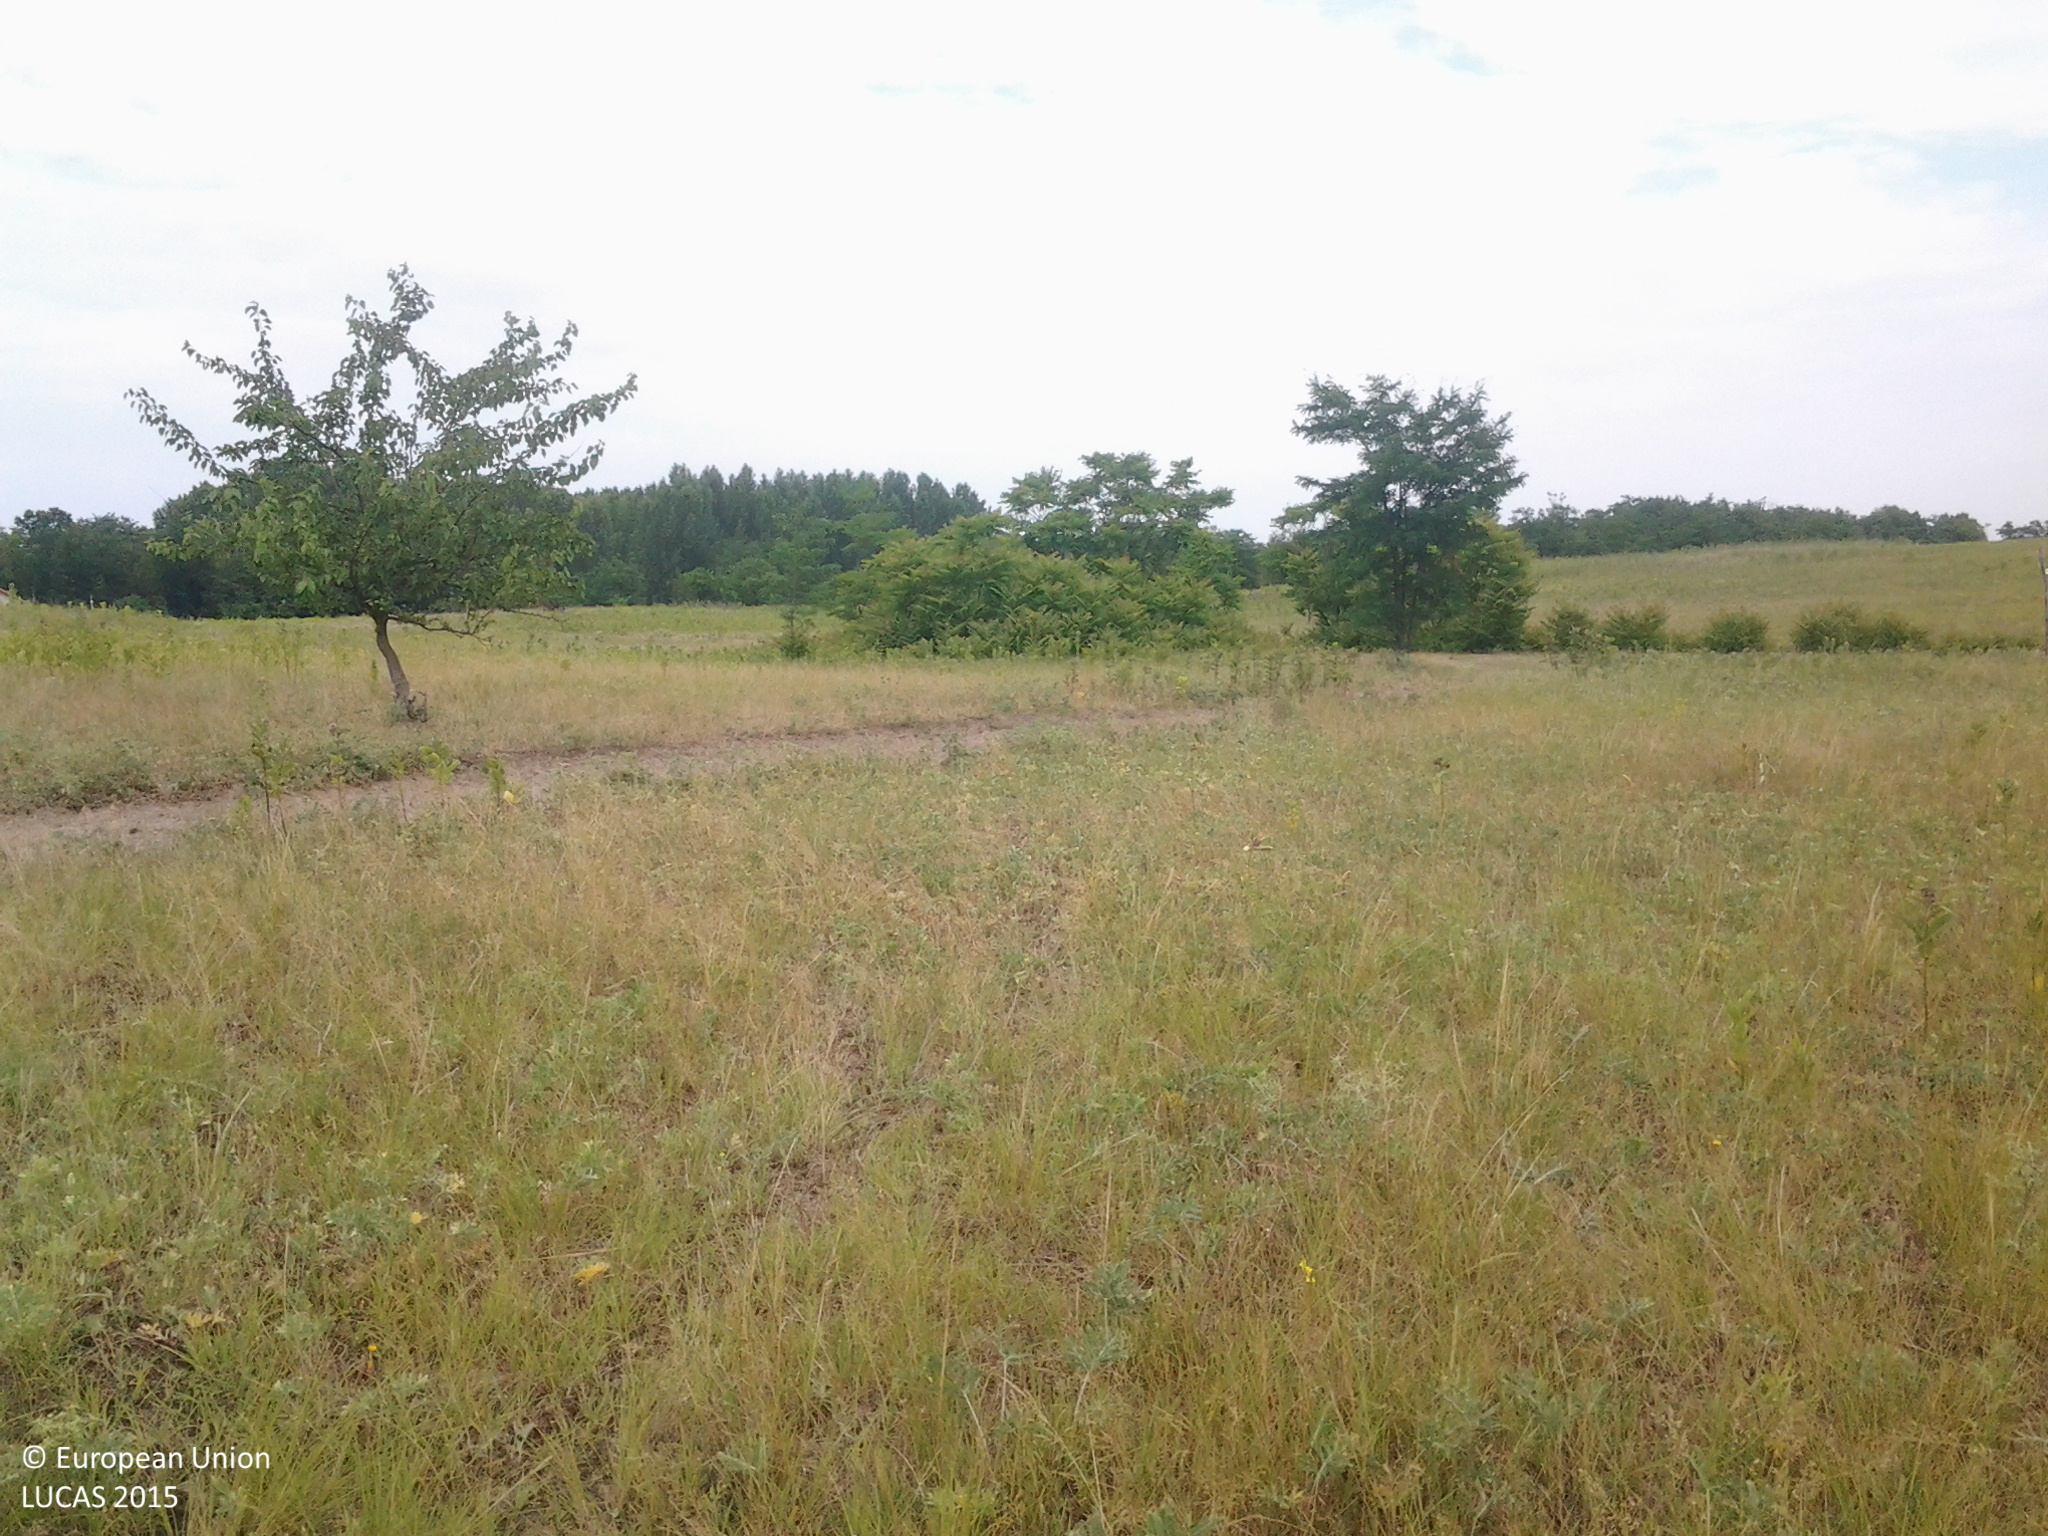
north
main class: Grassland
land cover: Spontaneously vegetated surfaces
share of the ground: > 75 %
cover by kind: herbaceous plants 95 %, shrubs 5 %
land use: Semi-natural and natural areas not in use
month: June
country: HU
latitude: 46.8345
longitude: 19.2864
